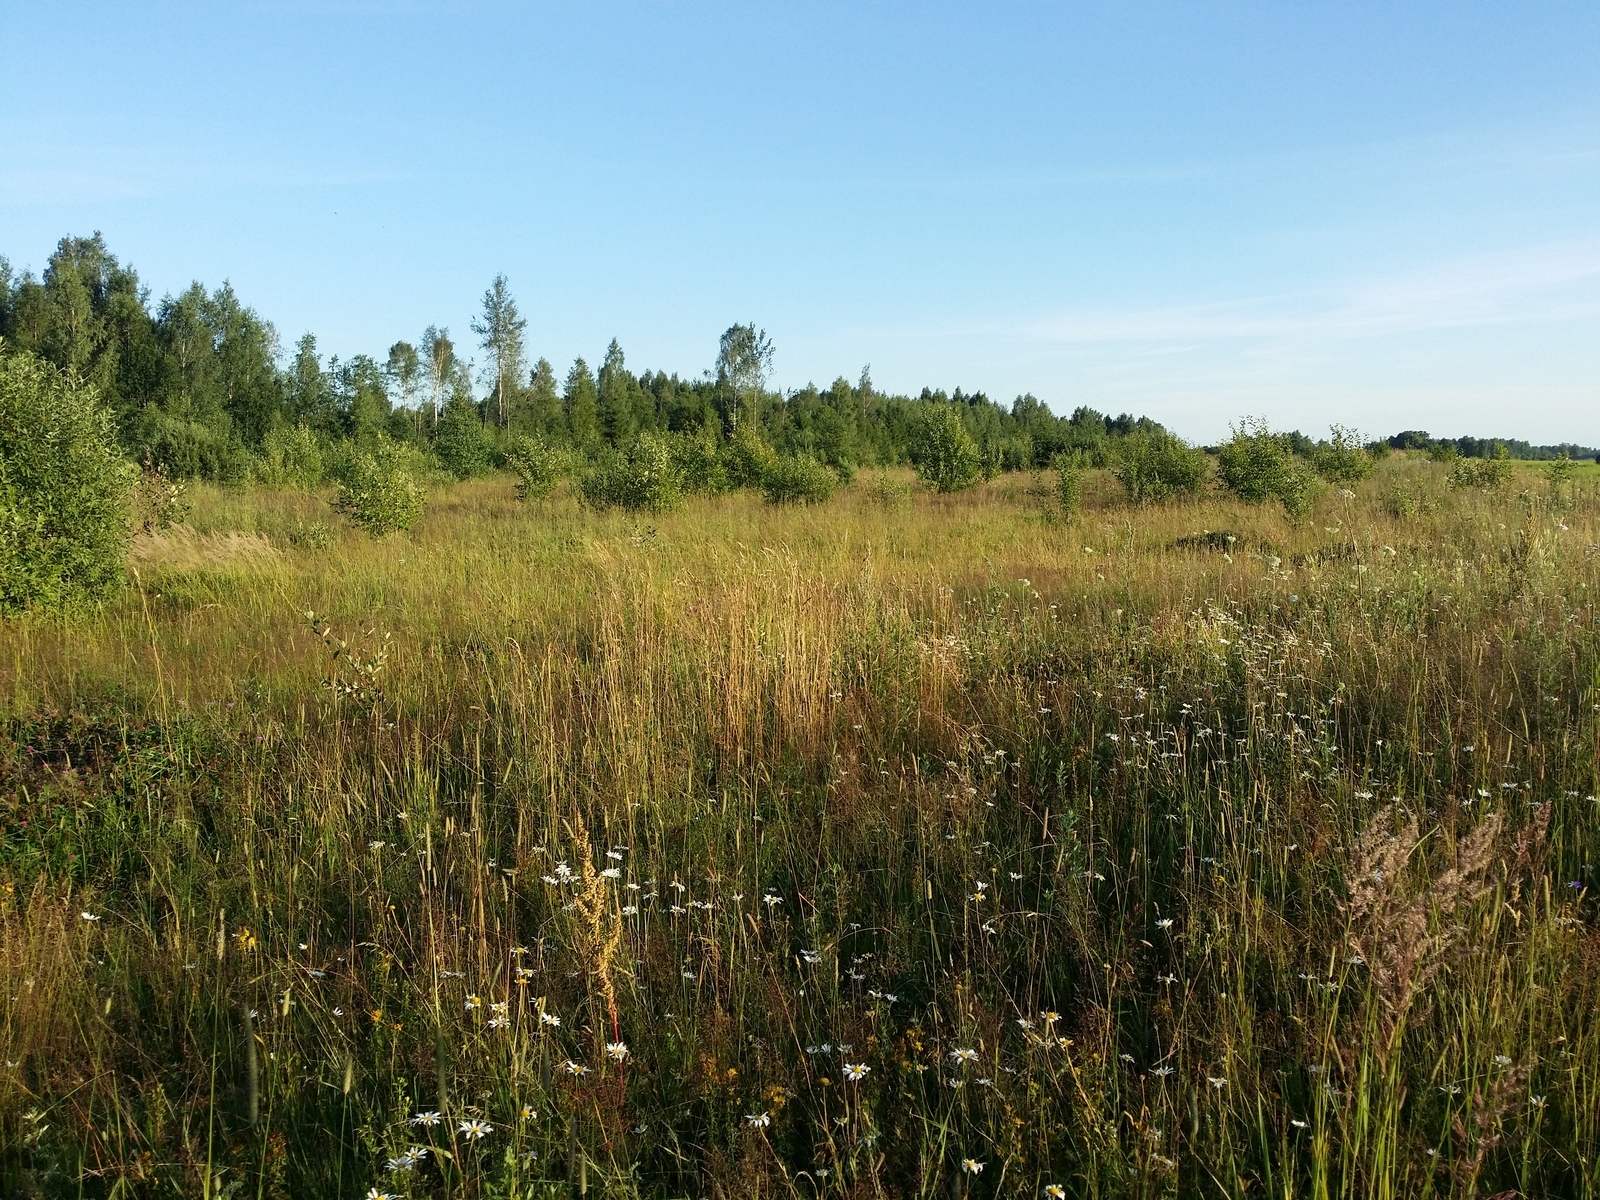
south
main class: Grassland
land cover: Spontaneously vegetated surfaces
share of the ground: > 75 %
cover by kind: herbaceous plants 100 %
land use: Semi-natural and natural areas not in use
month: July
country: LV
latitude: 57.1124
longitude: 27.2245
